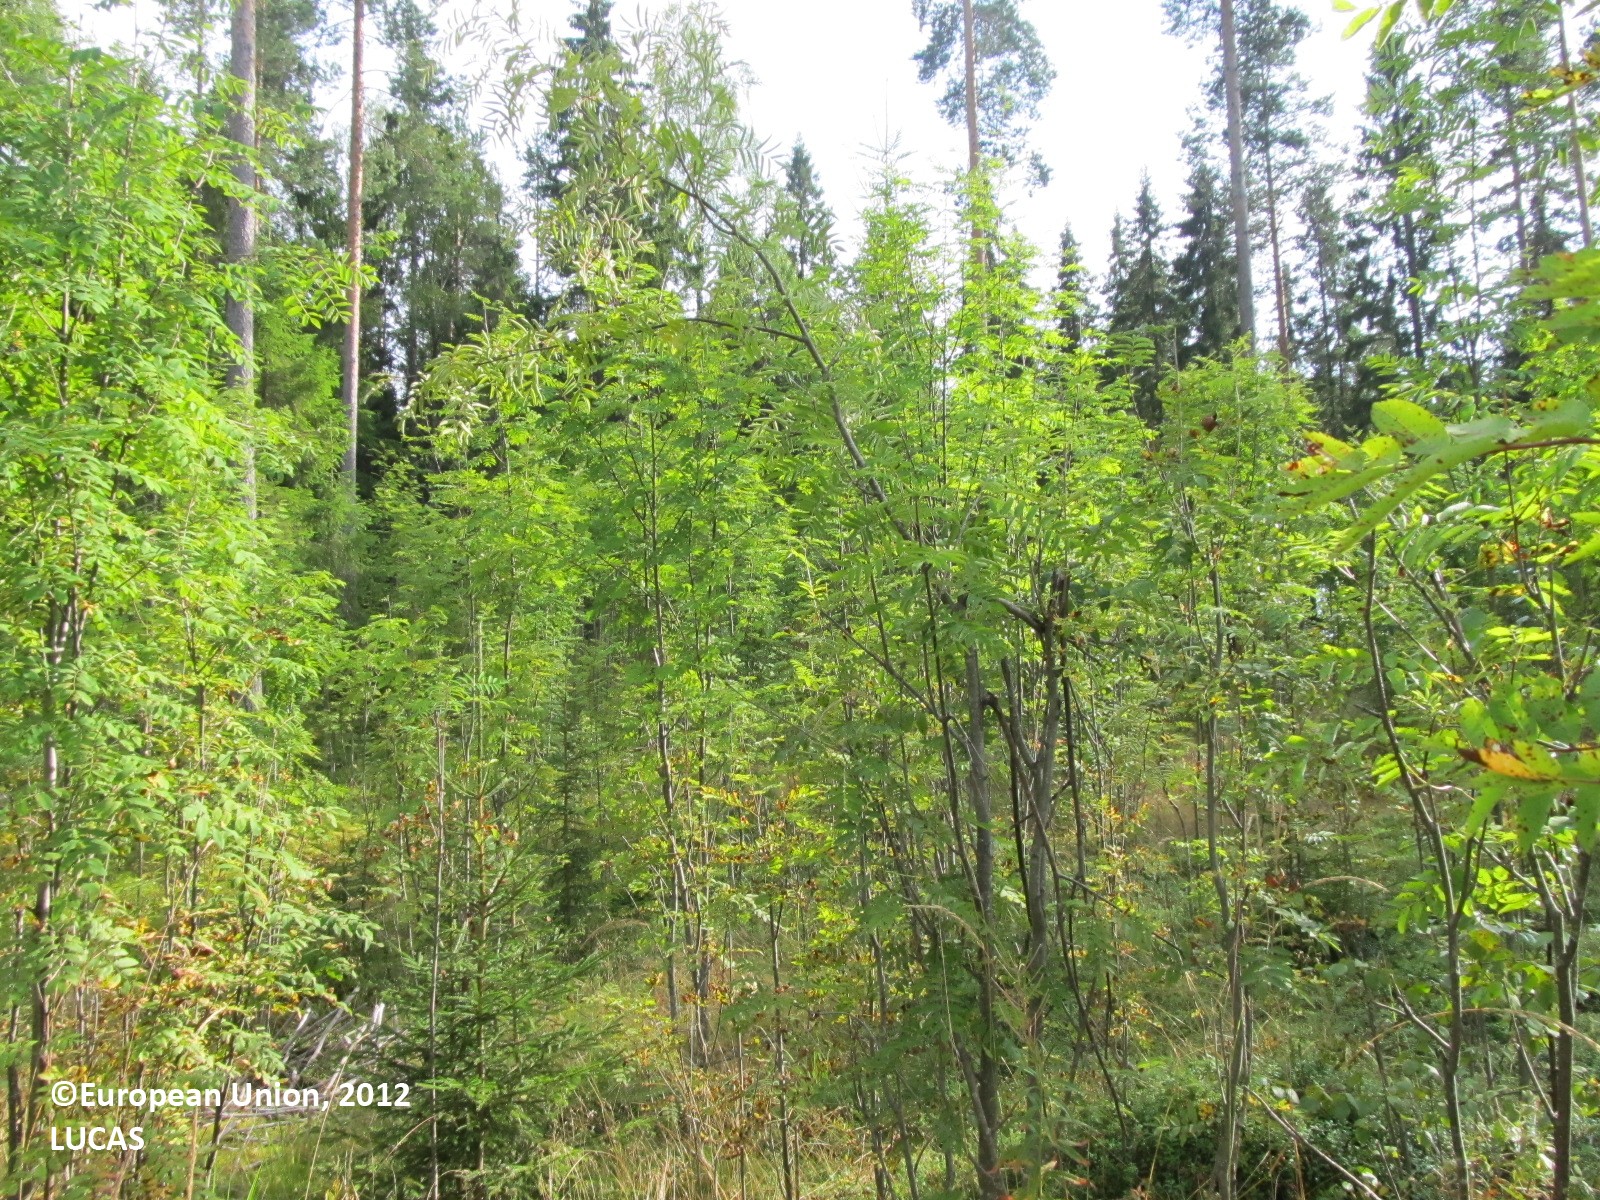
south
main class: Woodland
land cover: Pine dominated mixed woodland
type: boreal forest
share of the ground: 25 - 50 %
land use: Forestry
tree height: > 5 m
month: August
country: FI
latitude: 61.9193
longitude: 27.5621
